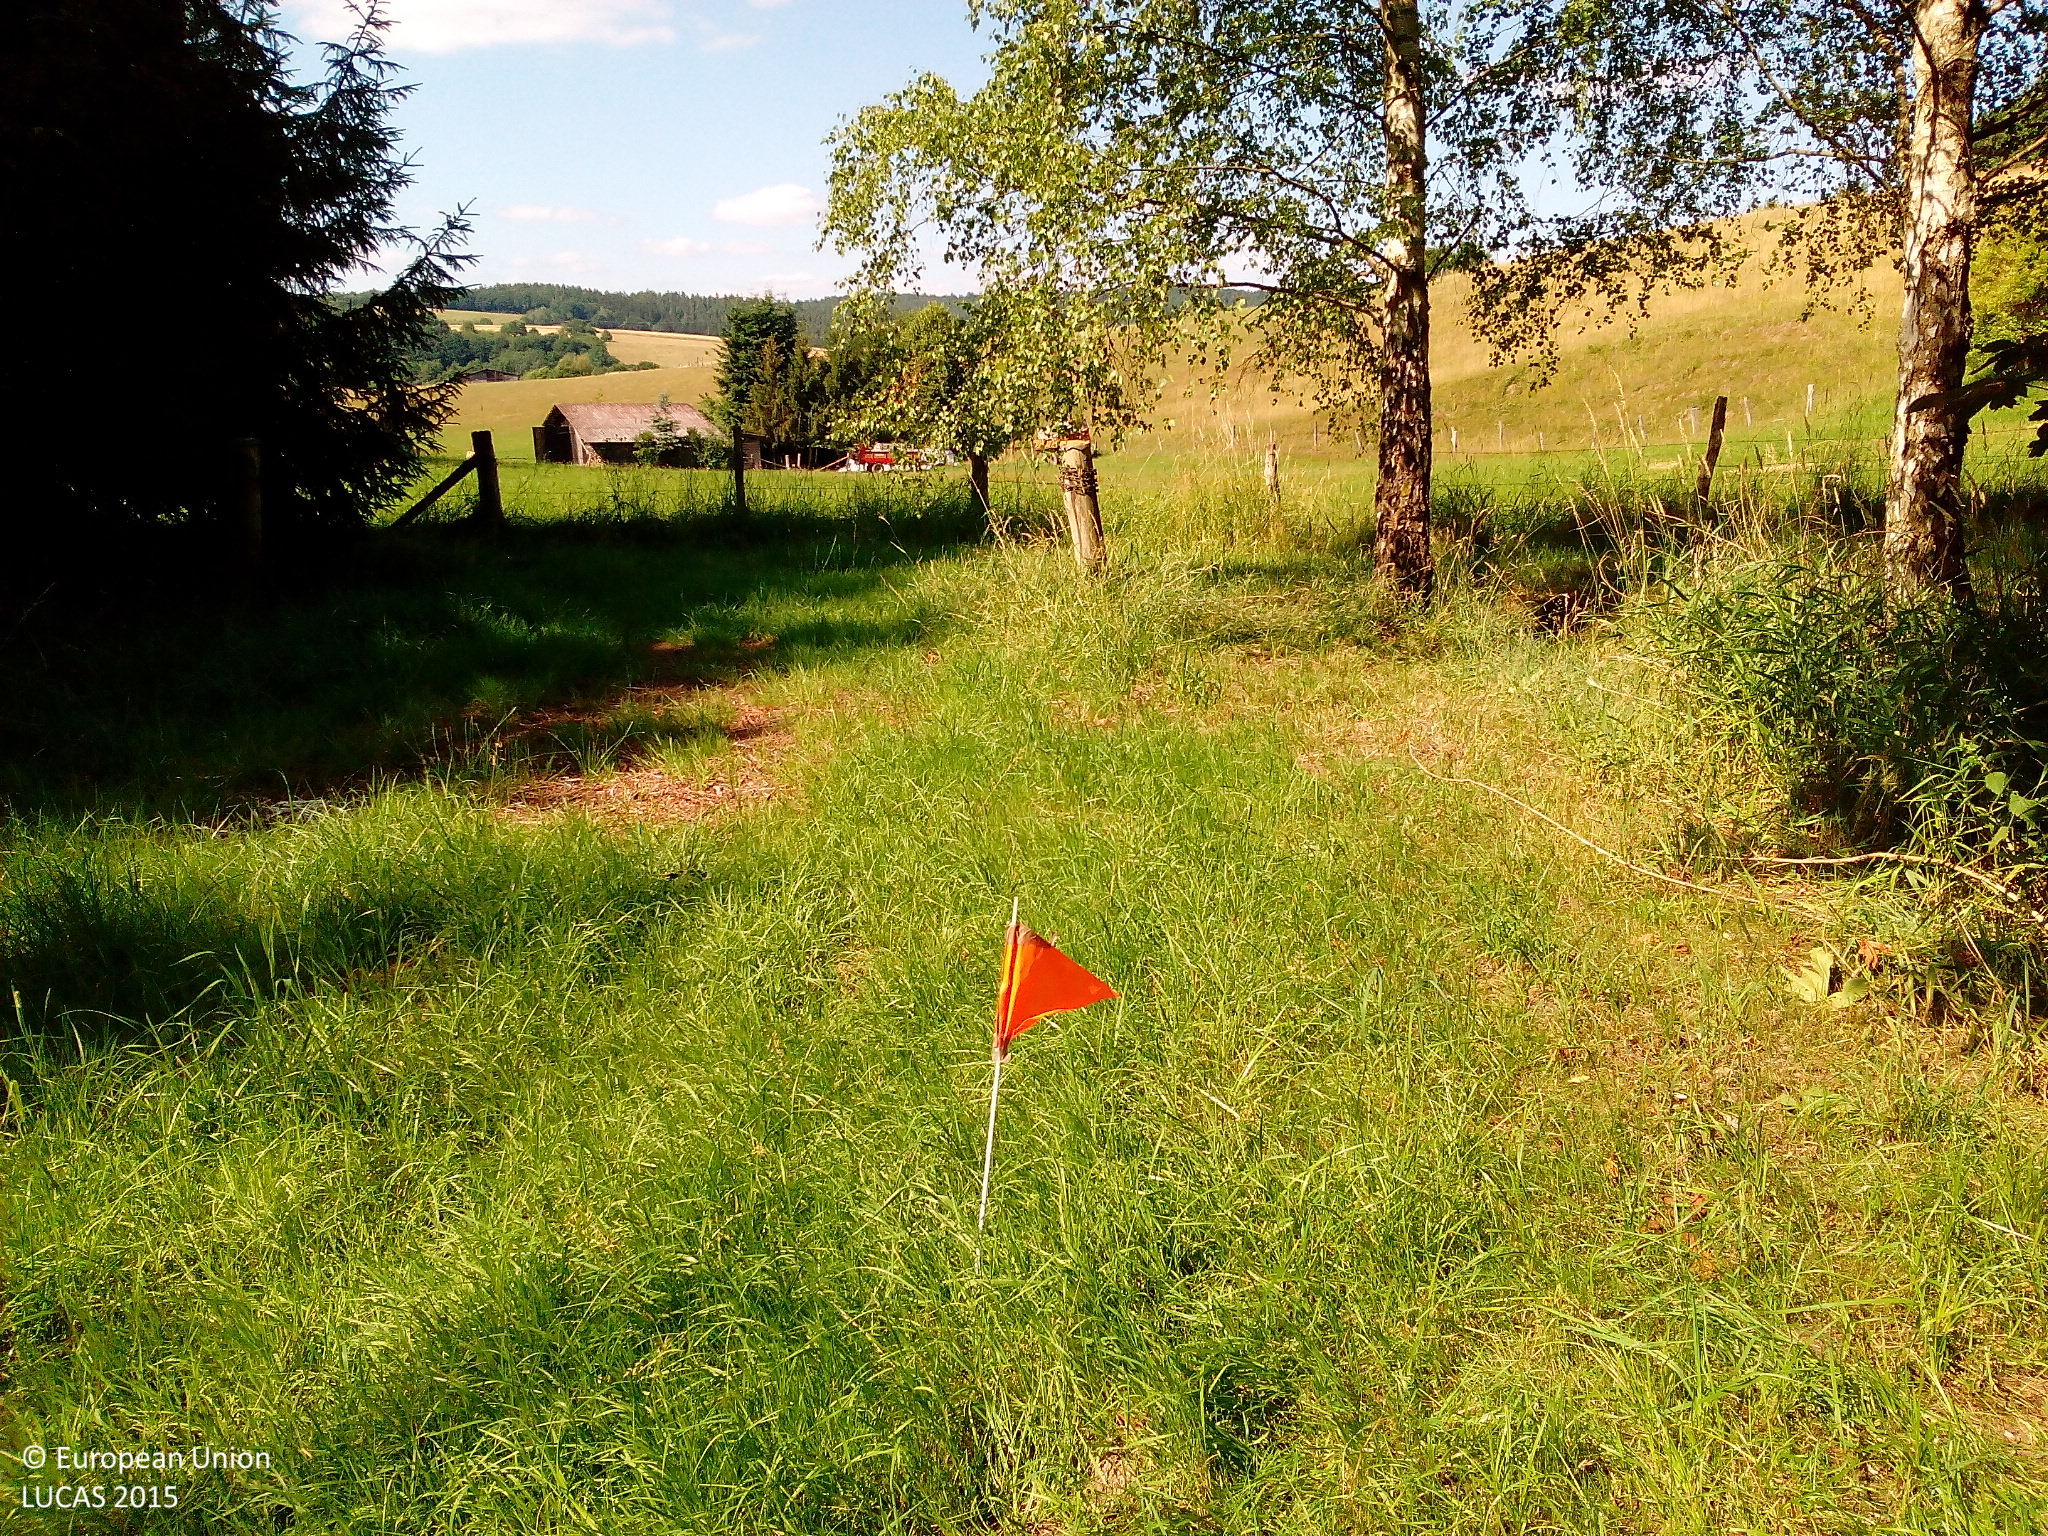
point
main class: Grassland
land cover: Grassland without tree/shrub cover
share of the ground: > 75 %
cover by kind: herbaceous plants 100 %
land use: Agriculture (excluding fallow land and kitchen gardens)
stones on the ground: < 10 %
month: July
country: DE
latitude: 50.9393
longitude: 9.8720
